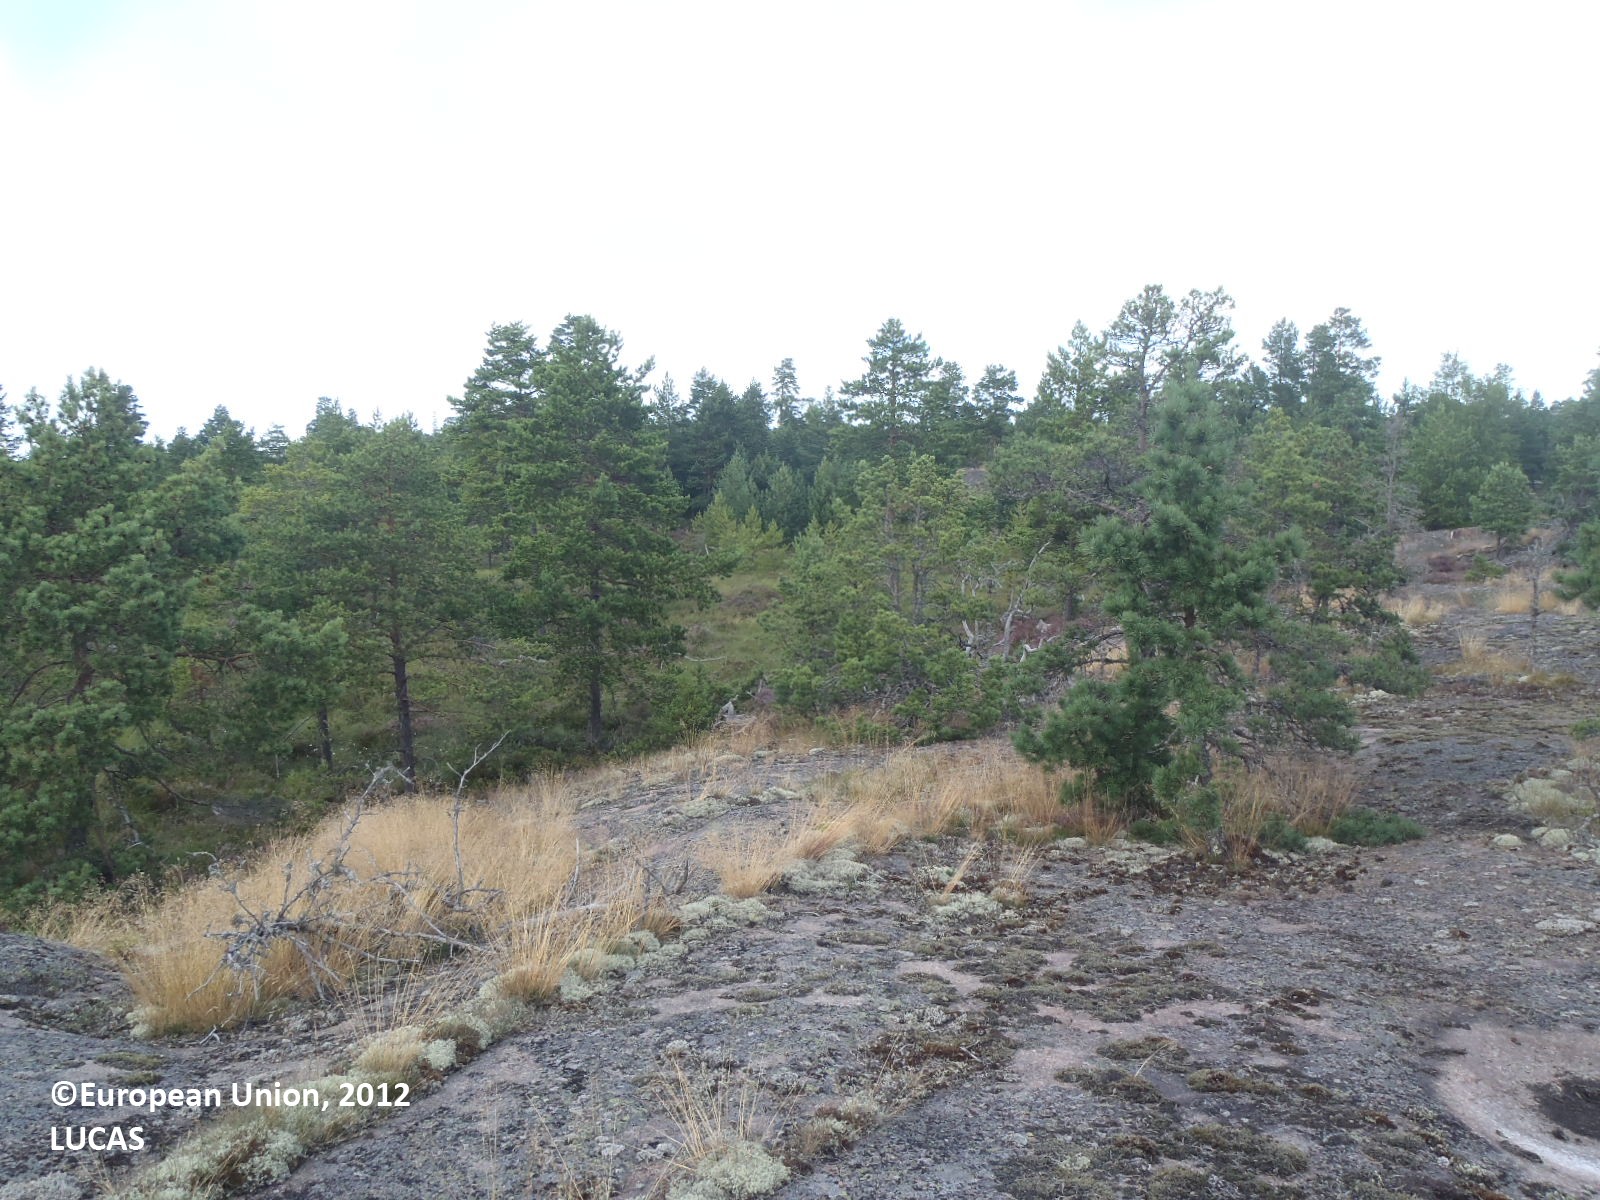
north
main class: Woodland
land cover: Pine dominated coniferous woodland
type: boreal forest
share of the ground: 10 - 25 %
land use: Semi-natural and natural areas not in use
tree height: > 5 m
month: August
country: FI
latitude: 60.3467
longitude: 20.3191
